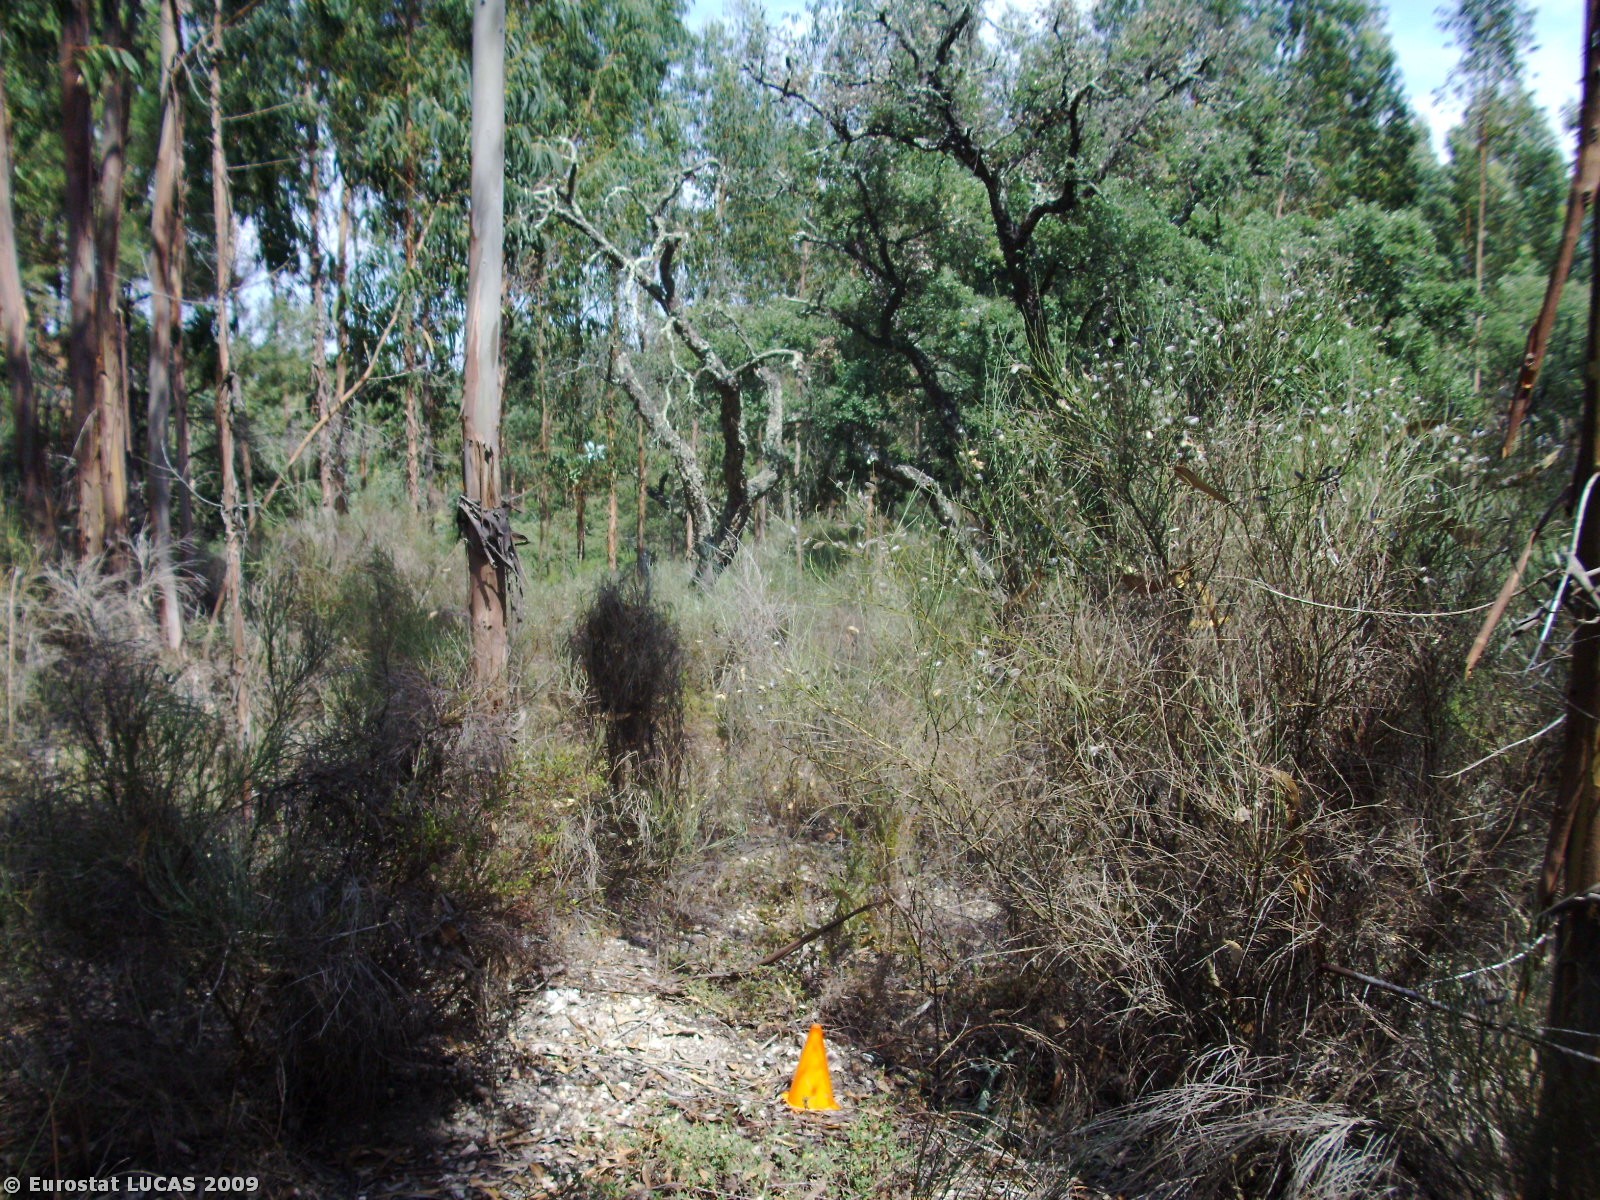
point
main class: Woodland
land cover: Broadleaved woodland
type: plantations and self-sown exotic forest
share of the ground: 50 - 75 %
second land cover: Spontaneously vegetated surfaces
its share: 10 - 25 %
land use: Forestry
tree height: > 5 m
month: August
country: PT
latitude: 39.2828
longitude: -8.1321
